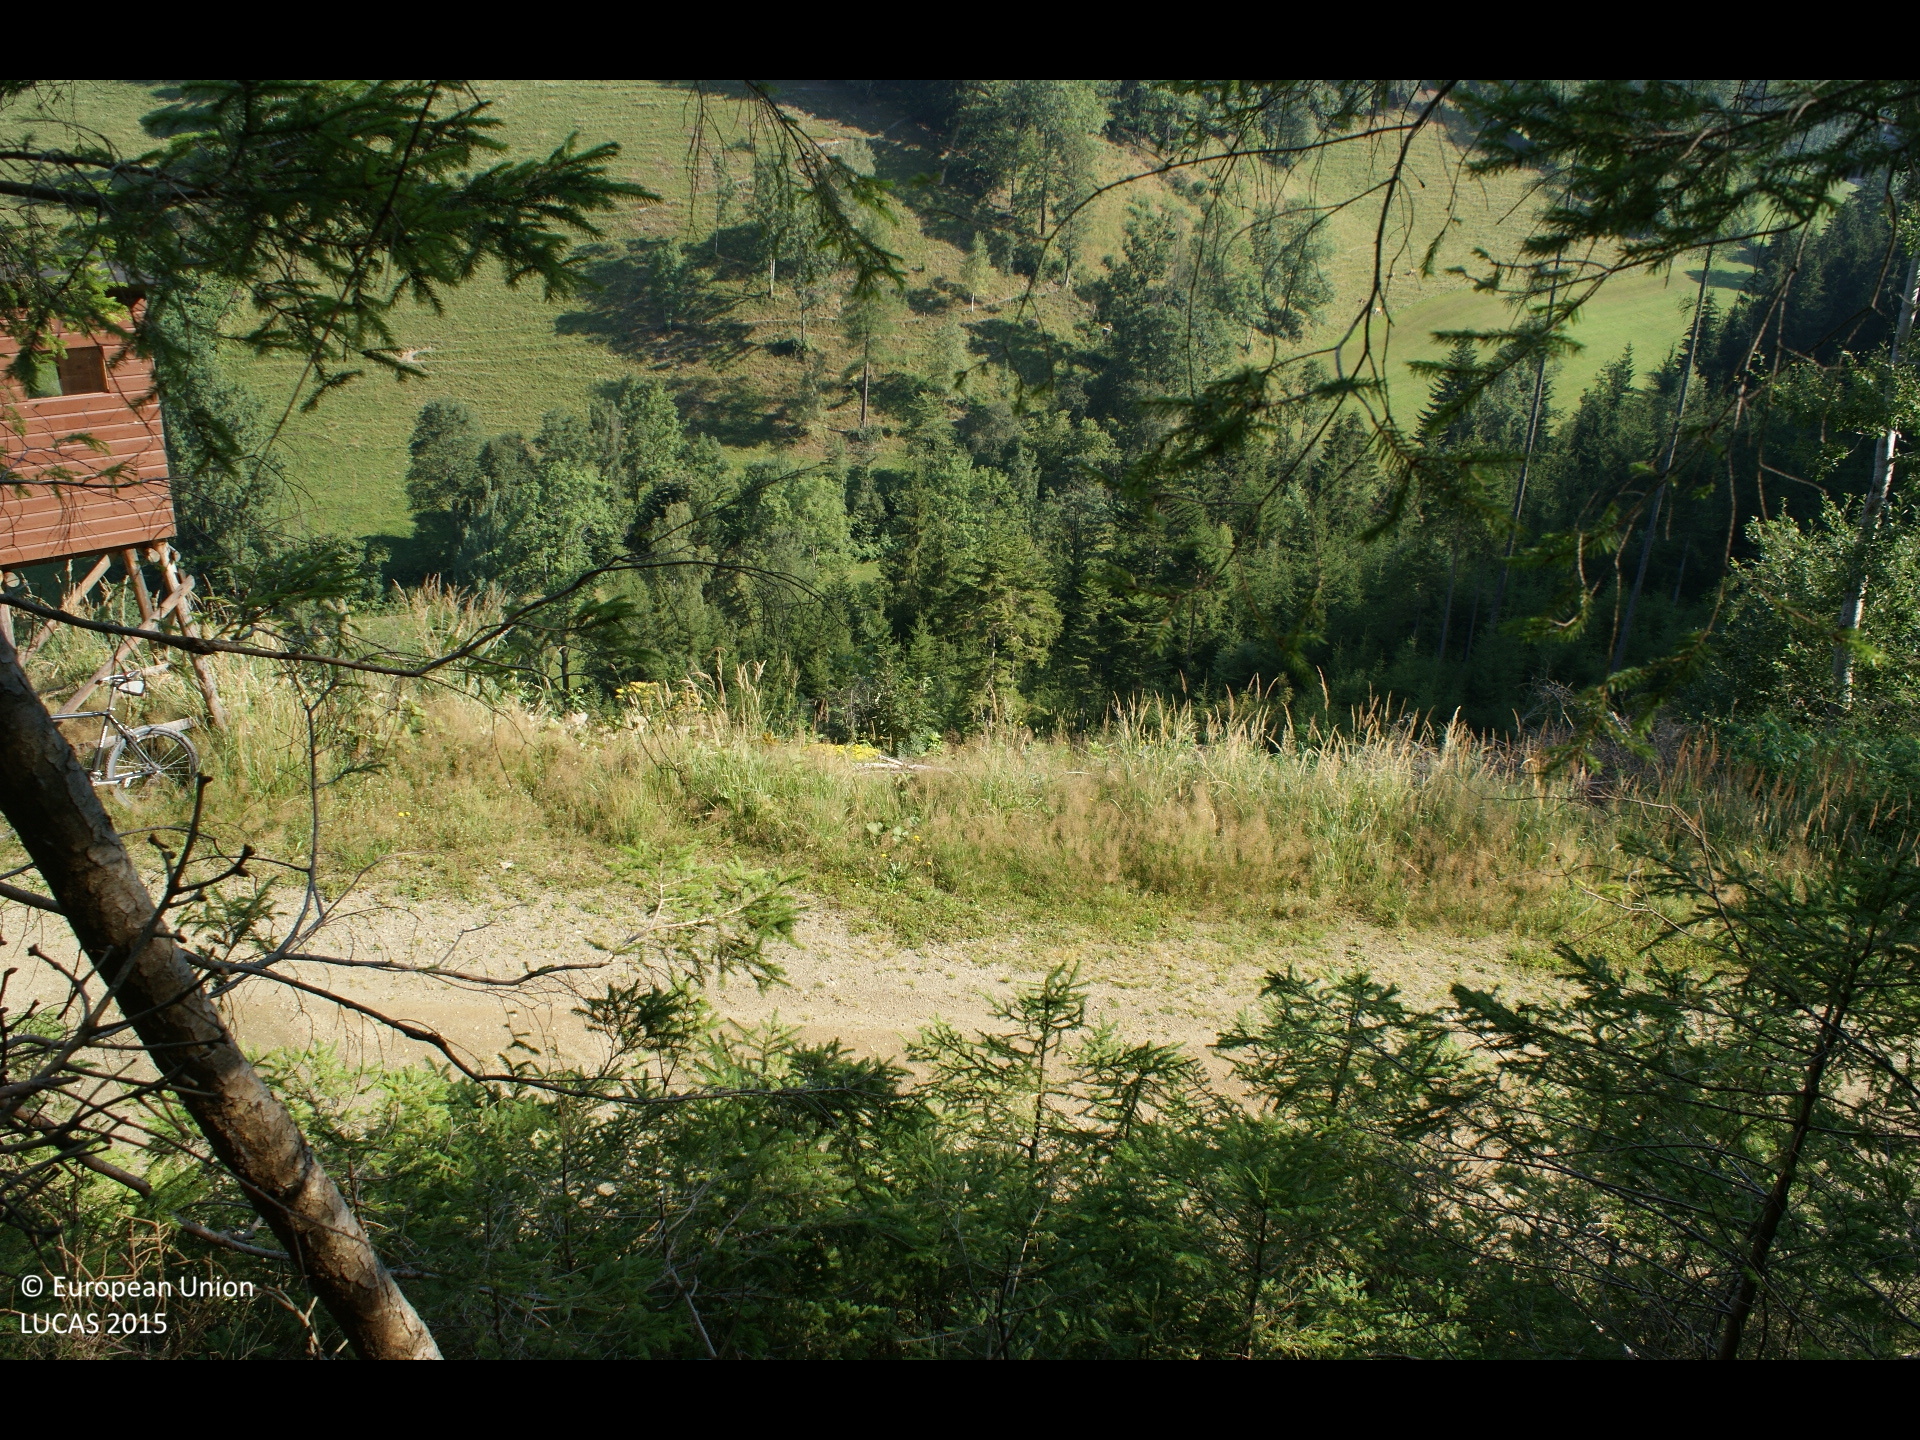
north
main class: Woodland
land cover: Spruce dominated coniferous woodland
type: alpine coniferous forest
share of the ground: > 75 %
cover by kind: coniferous forest trees 85 %, lichens and mosses 10 %, shrubs 5 %
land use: Forestry
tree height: > 5 m
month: August
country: AT
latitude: 47.5969
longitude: 15.5472
